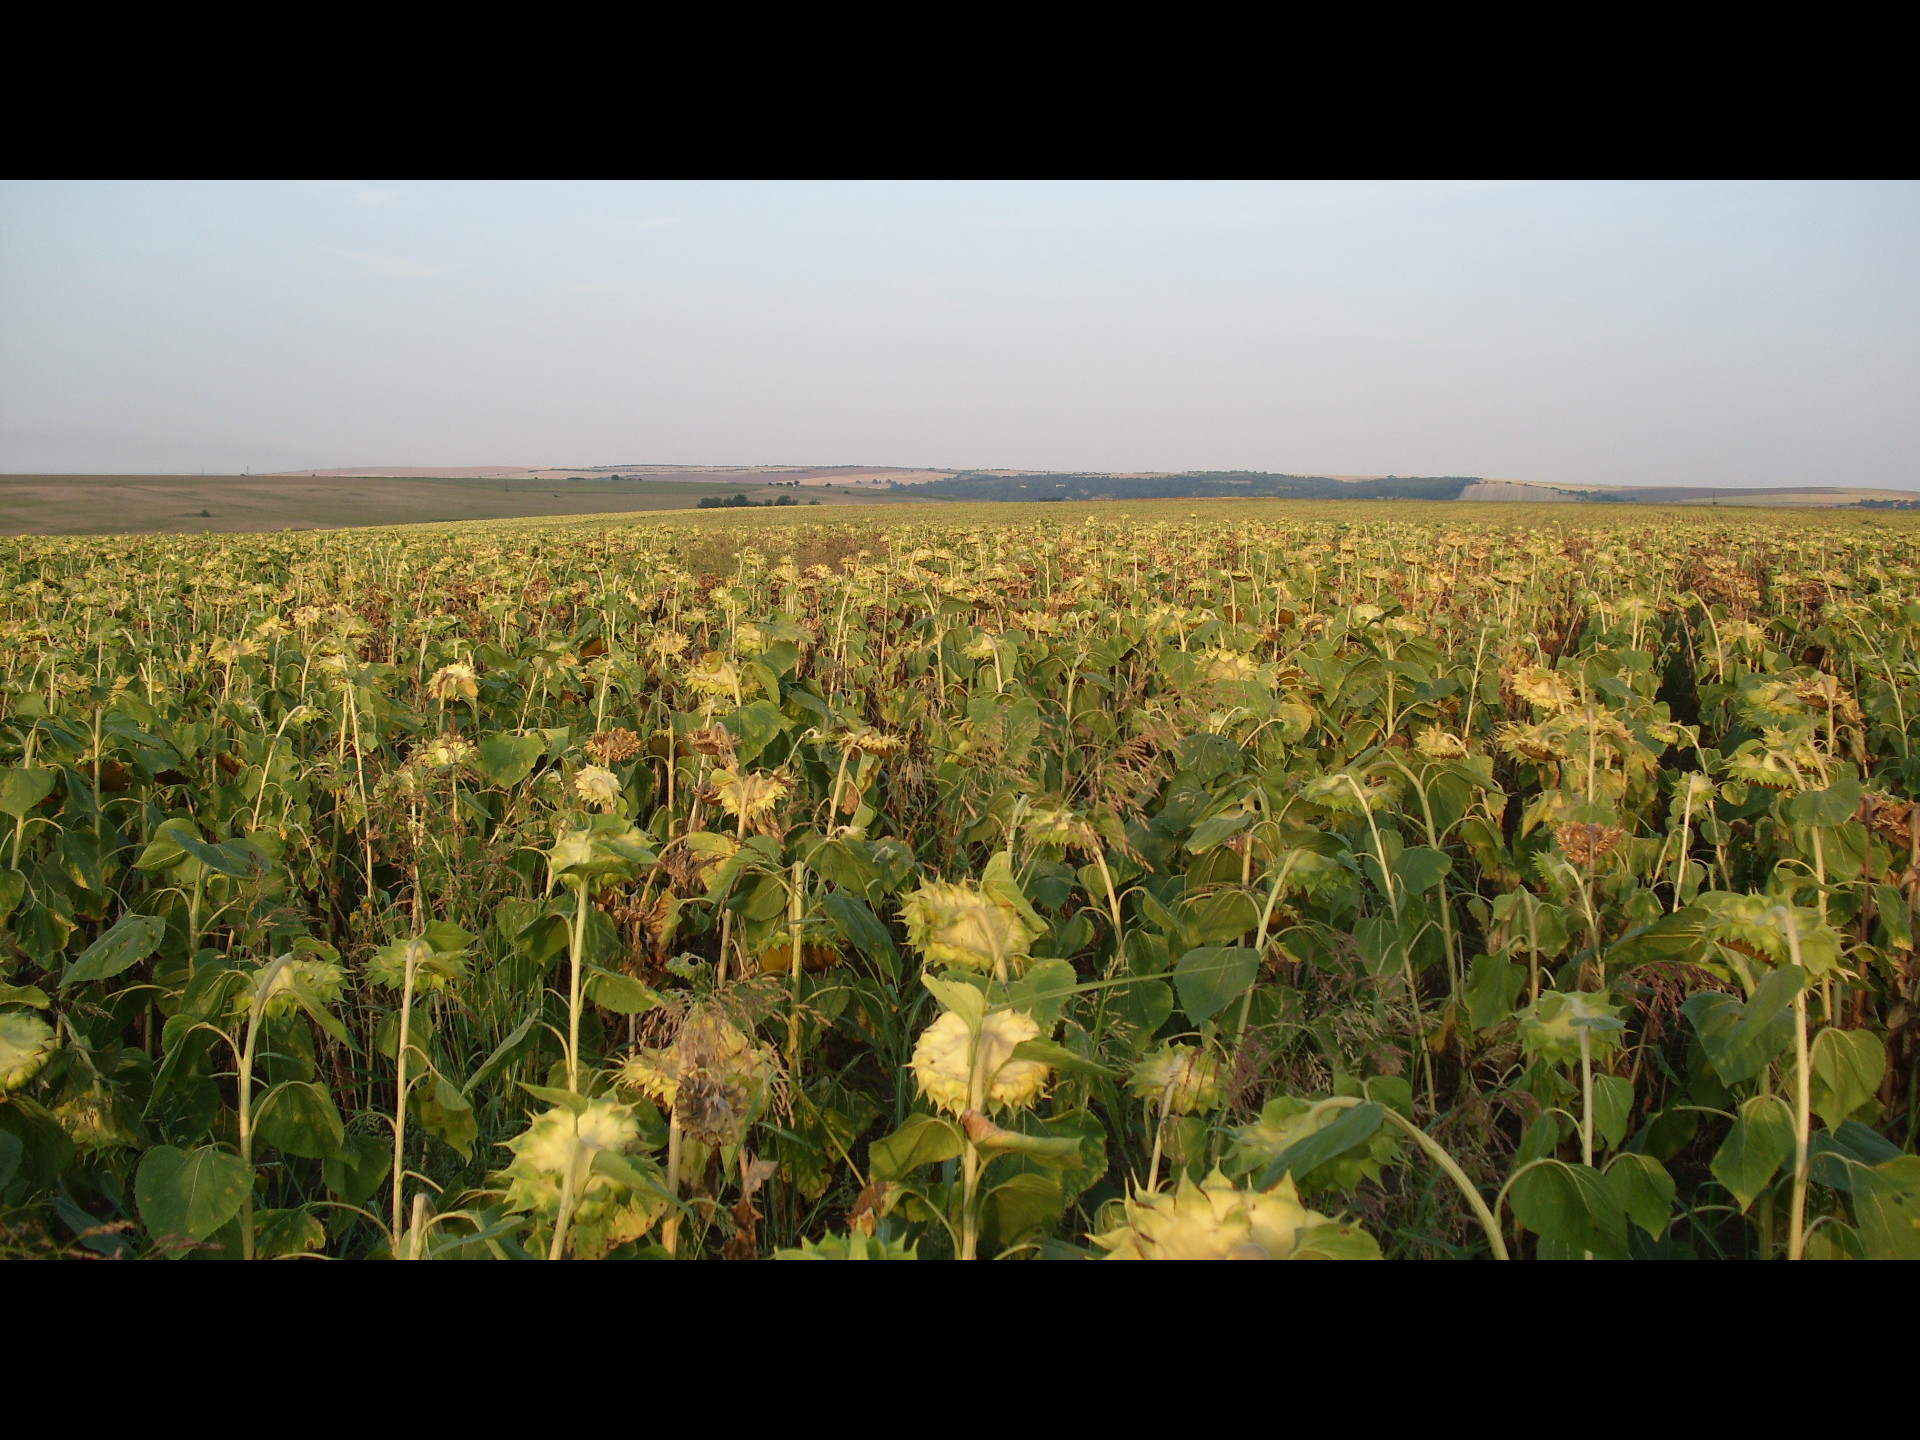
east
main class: Cropland
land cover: Sunflower
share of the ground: > 75 %
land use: Agriculture (excluding fallow land and kitchen gardens)
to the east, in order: Sunflower
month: August
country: BG
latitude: 43.5951
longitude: 23.6109
